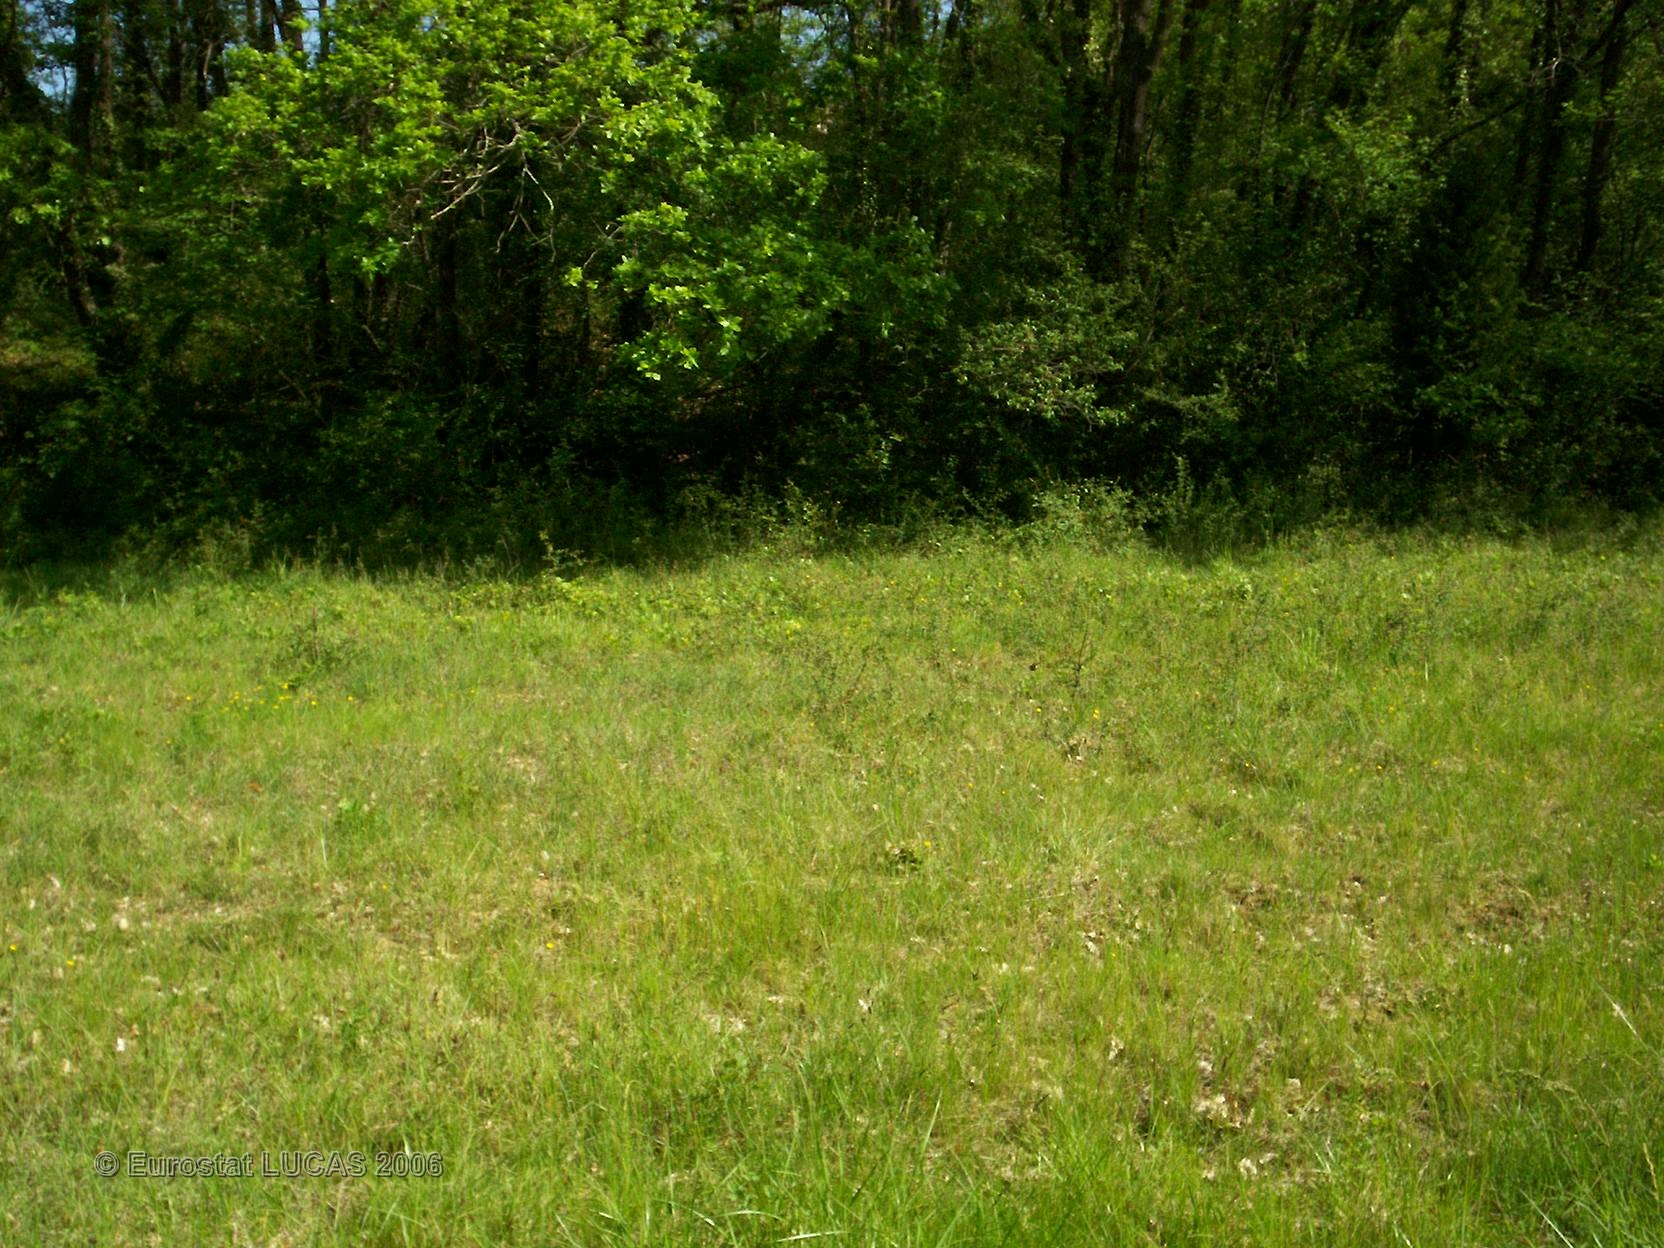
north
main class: Grassland
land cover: Grassland without tree/shrub cover
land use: Agriculture (excluding fallow land and kitchen gardens)
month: May
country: FR
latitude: 43.8008
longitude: 0.2624
